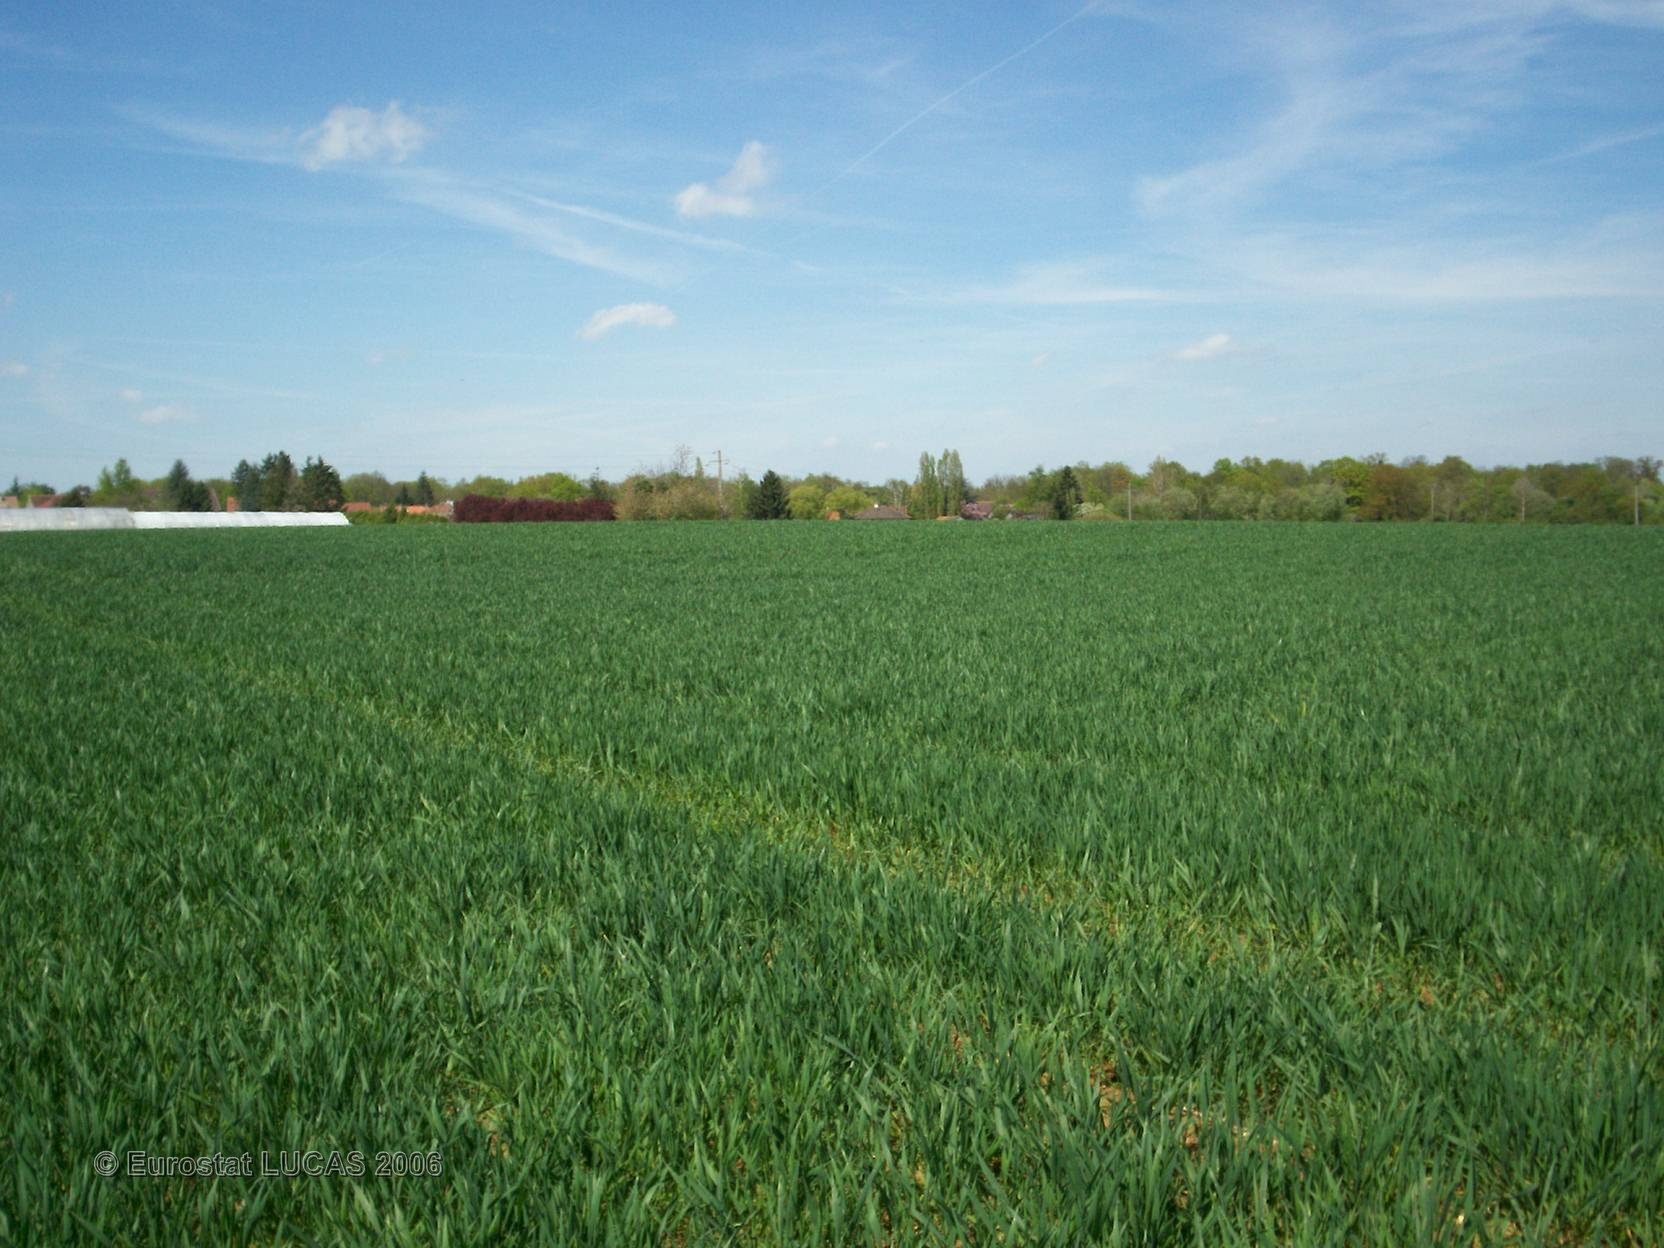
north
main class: Cropland
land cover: Common wheat
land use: Agriculture (excluding fallow land and kitchen gardens)
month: May
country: FR
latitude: 48.8001
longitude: 2.7884
